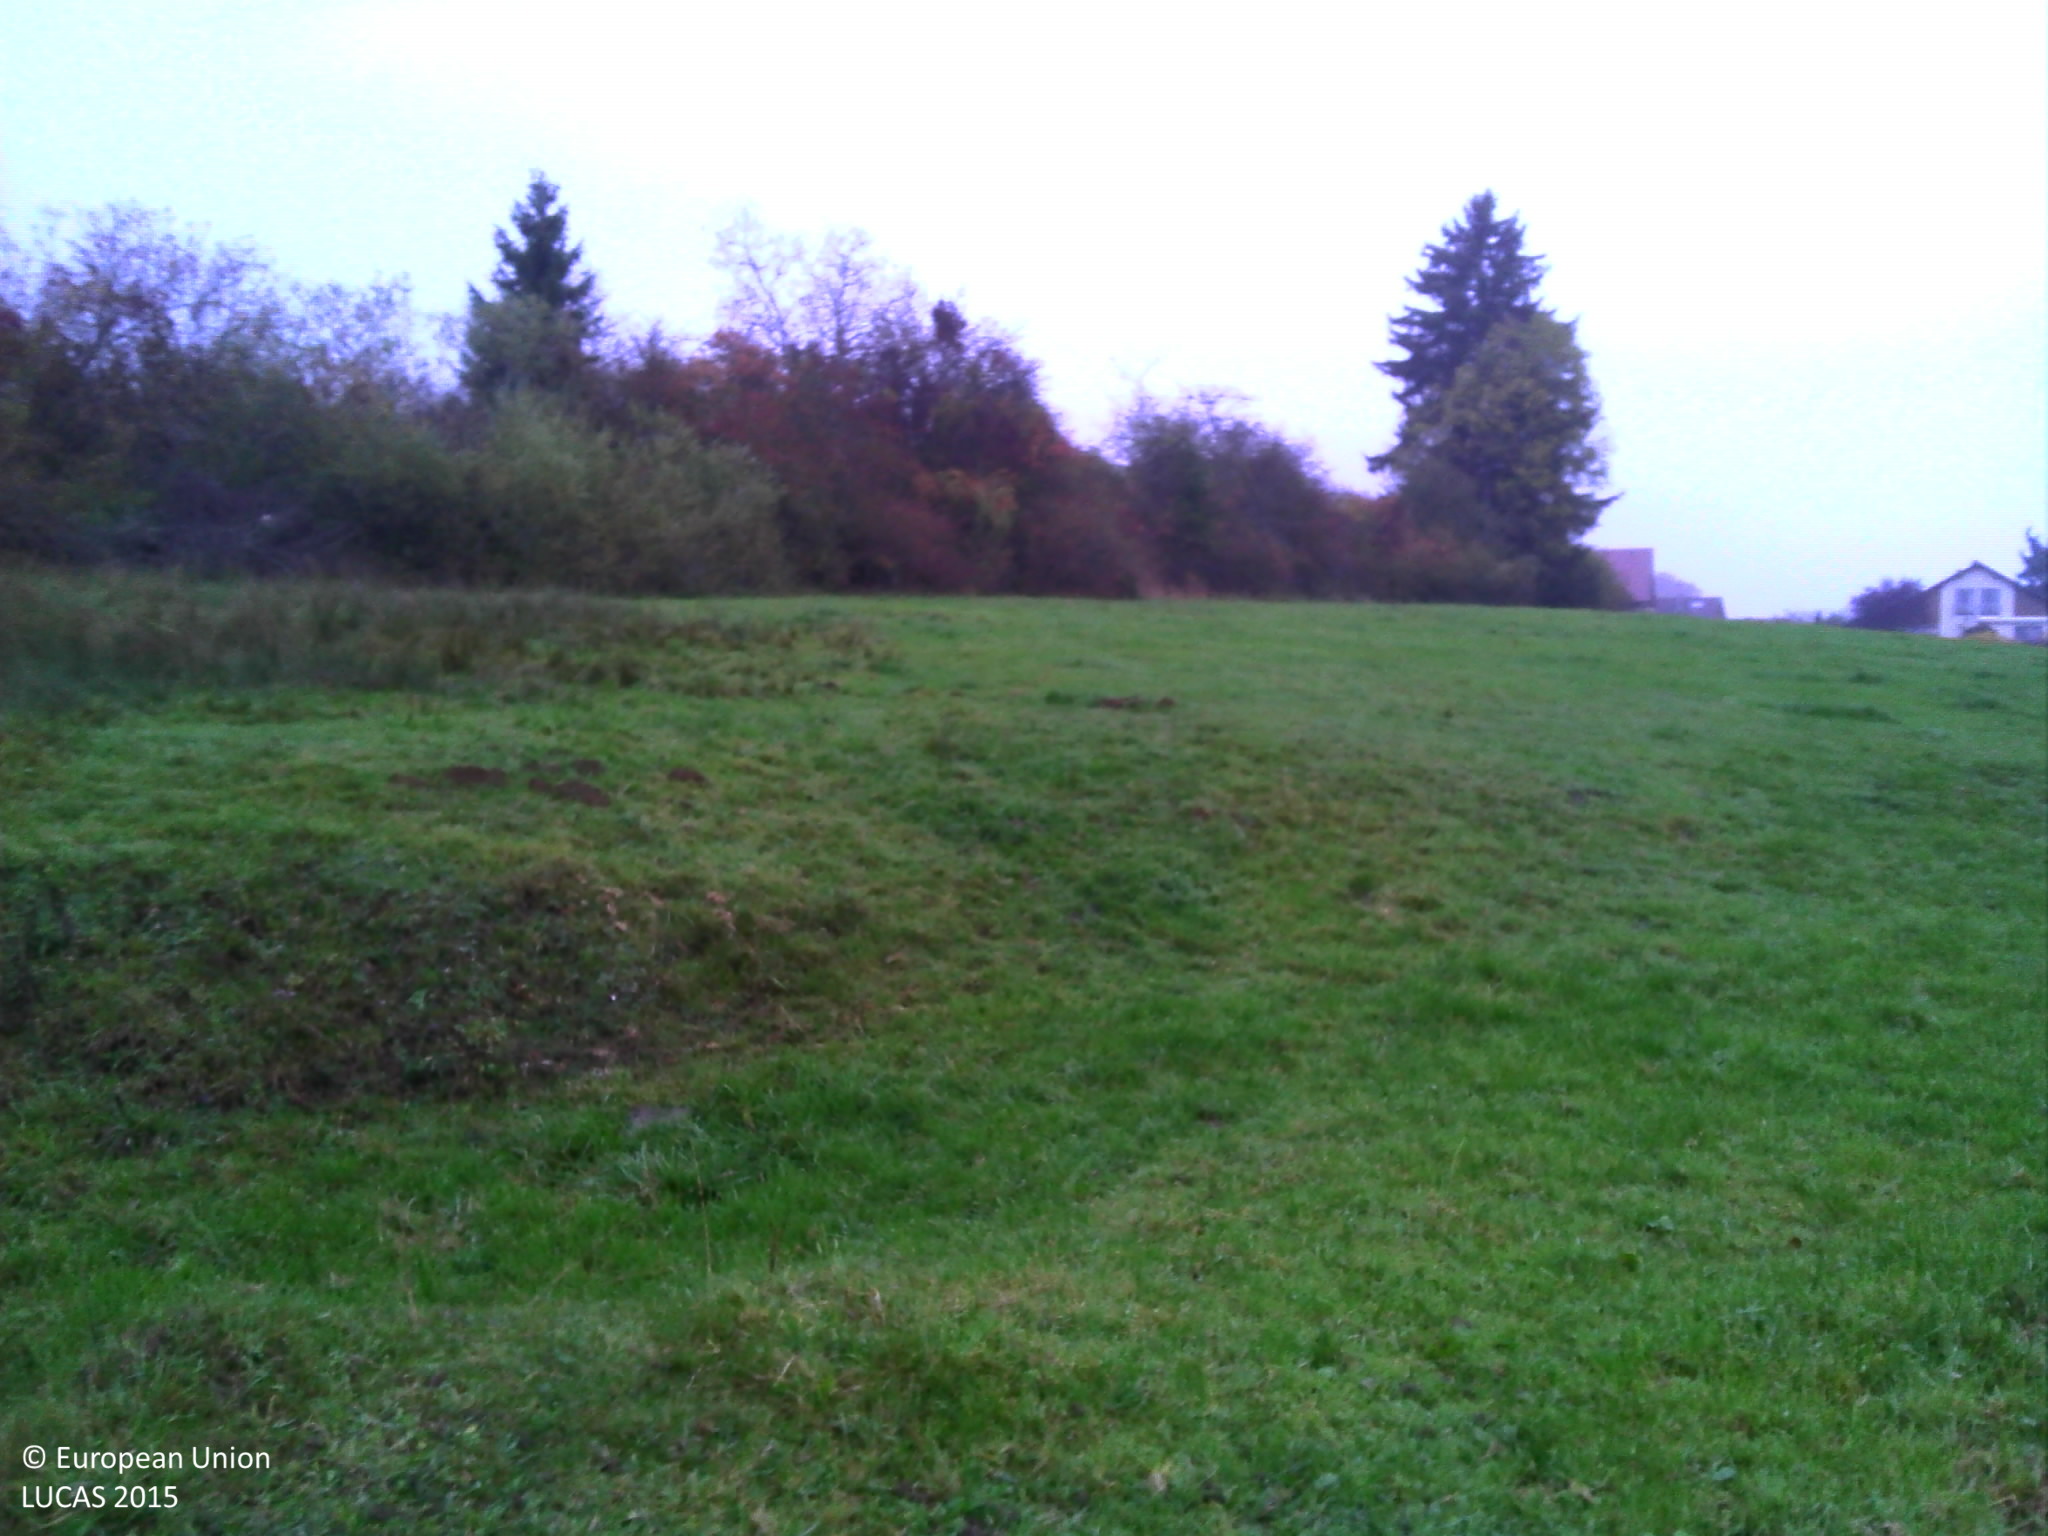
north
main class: Grassland
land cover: Grassland without tree/shrub cover
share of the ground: > 75 %
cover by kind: herbaceous plants 100 %
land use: Agriculture (excluding fallow land and kitchen gardens)
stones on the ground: < 10 %
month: October
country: FR
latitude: 46.8098
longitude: 6.2939
